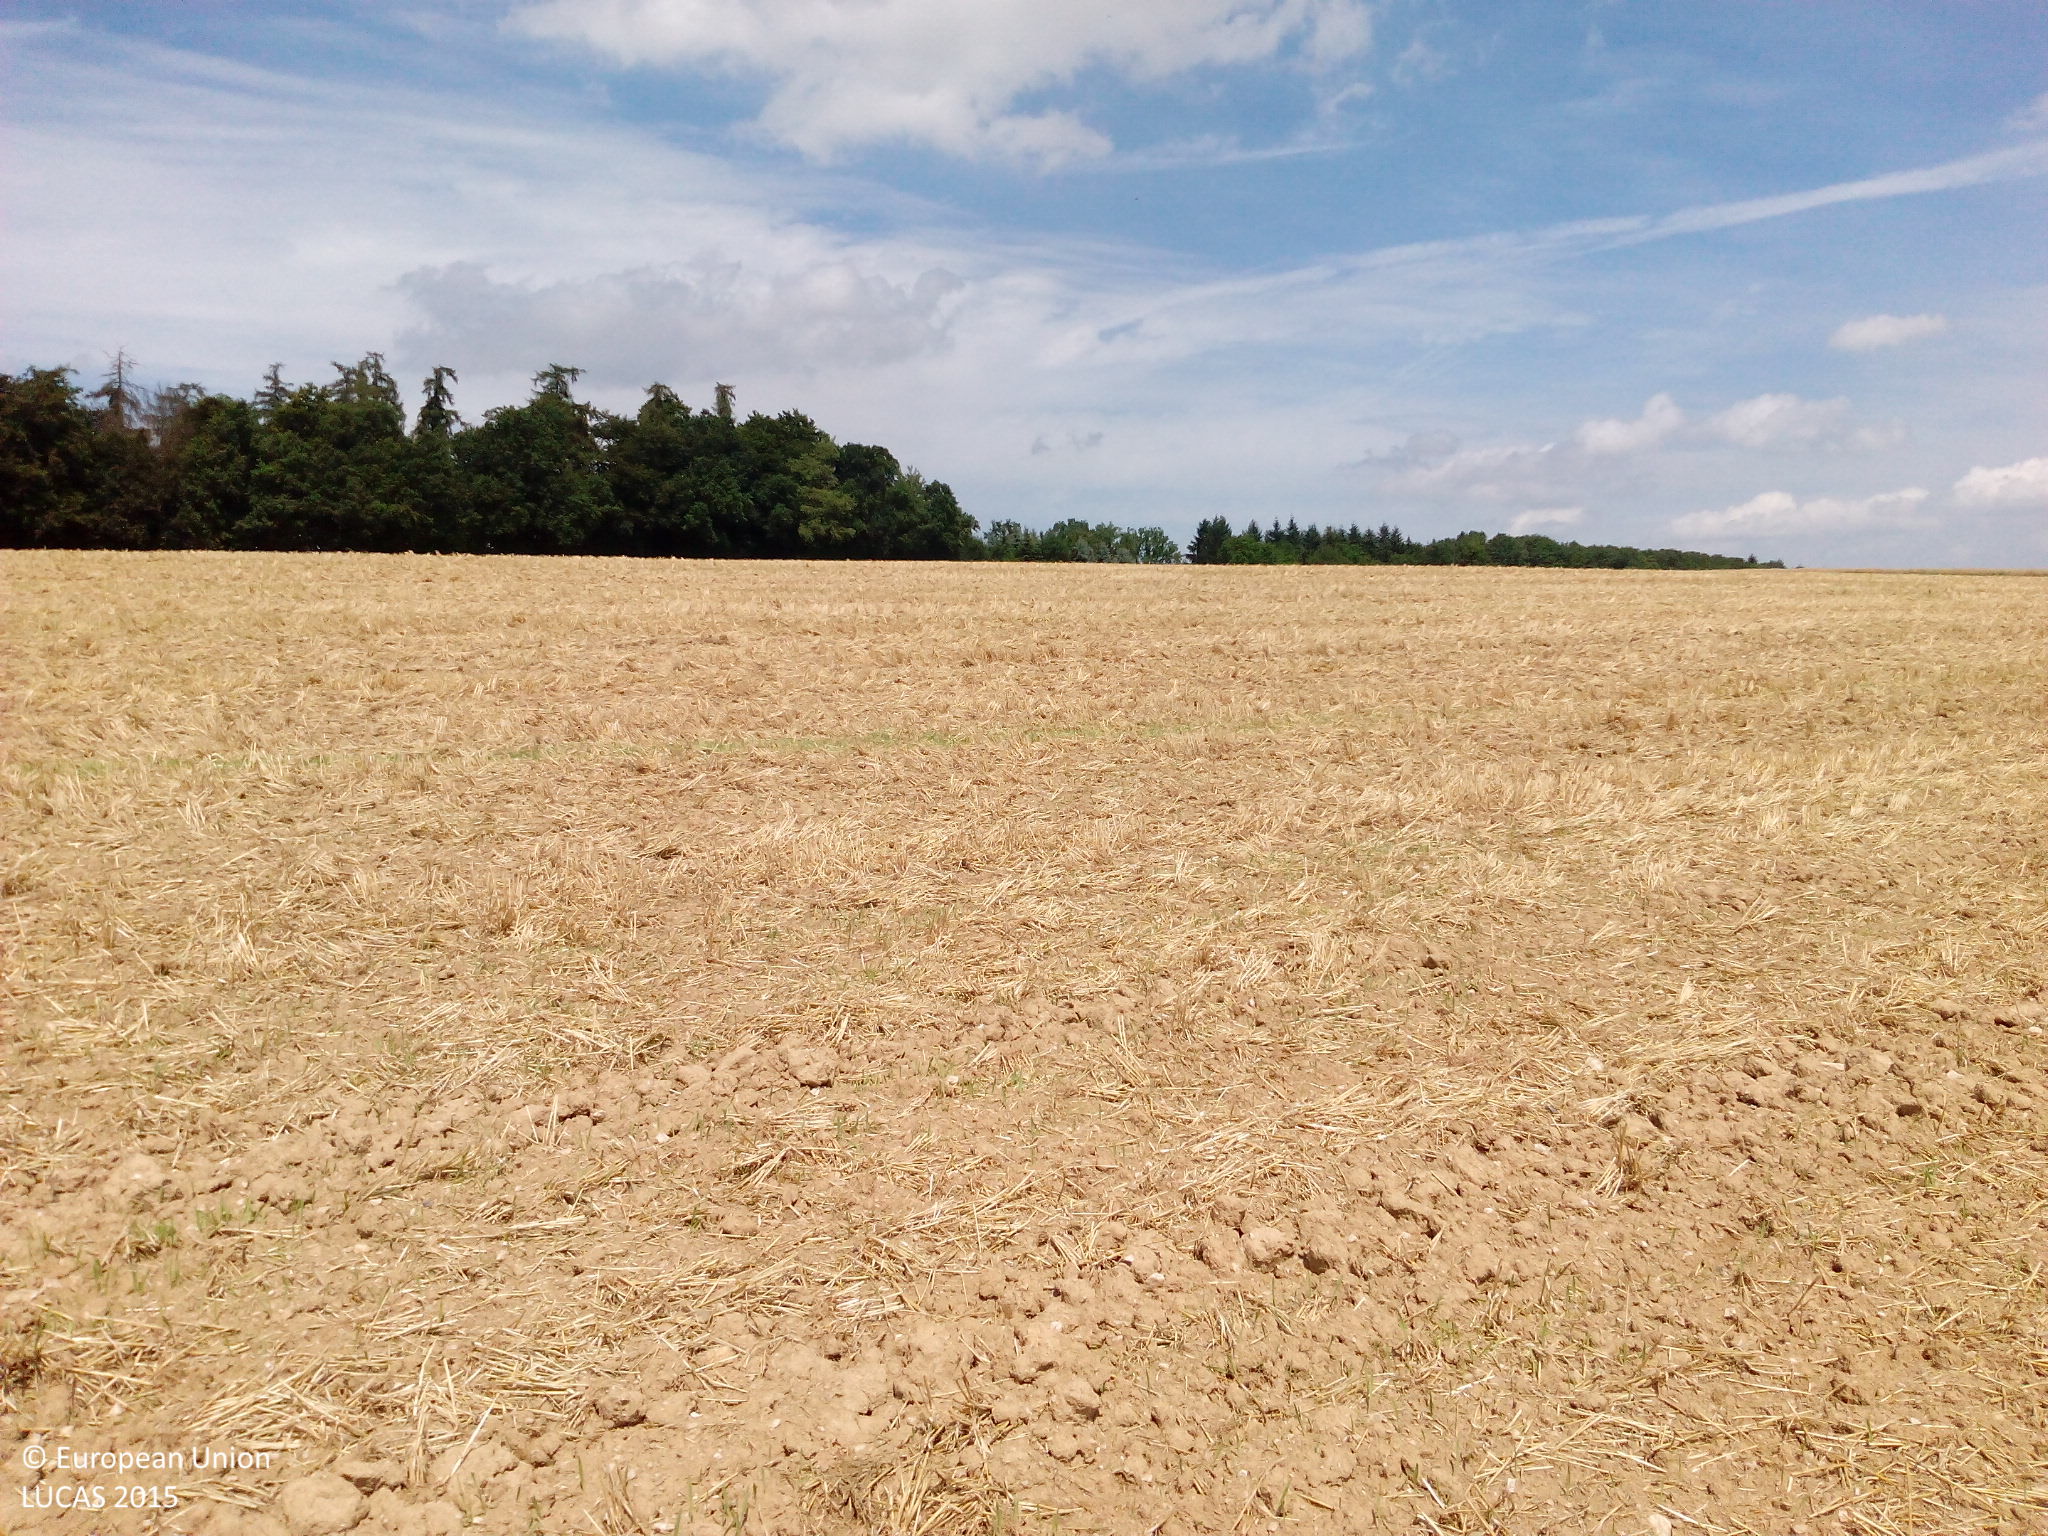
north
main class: Cropland
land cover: Barley
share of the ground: < 10 %
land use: Agriculture (excluding fallow land and kitchen gardens)
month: July
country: DE
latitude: 49.9417
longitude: 7.5340
